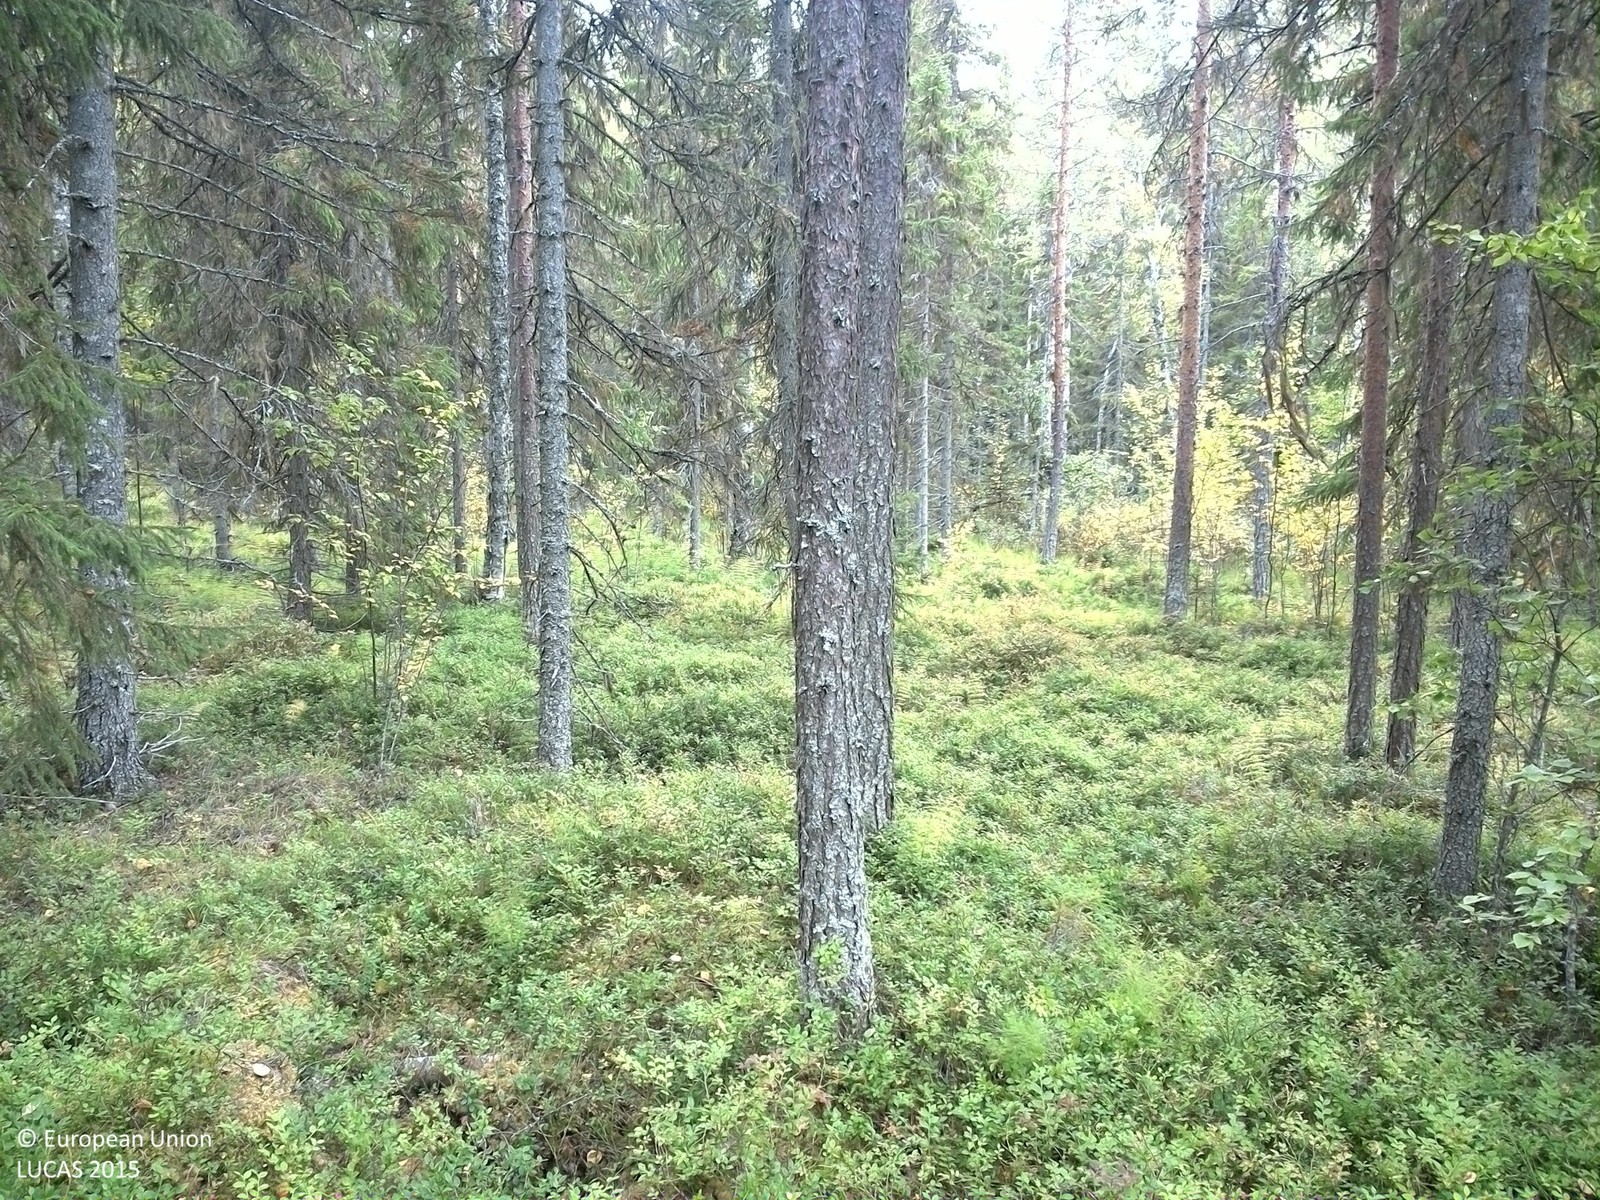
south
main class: Woodland
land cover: Spruce dominated mixed woodland
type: boreal forest
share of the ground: 50 - 75 %
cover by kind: coniferous forest trees 40 %, shrubs 35 %, broadleaved forest trees 15 %, lichens and mosses 10 %
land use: Forestry
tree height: > 5 m
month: September
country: SE
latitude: 63.8662
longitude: 16.5036
